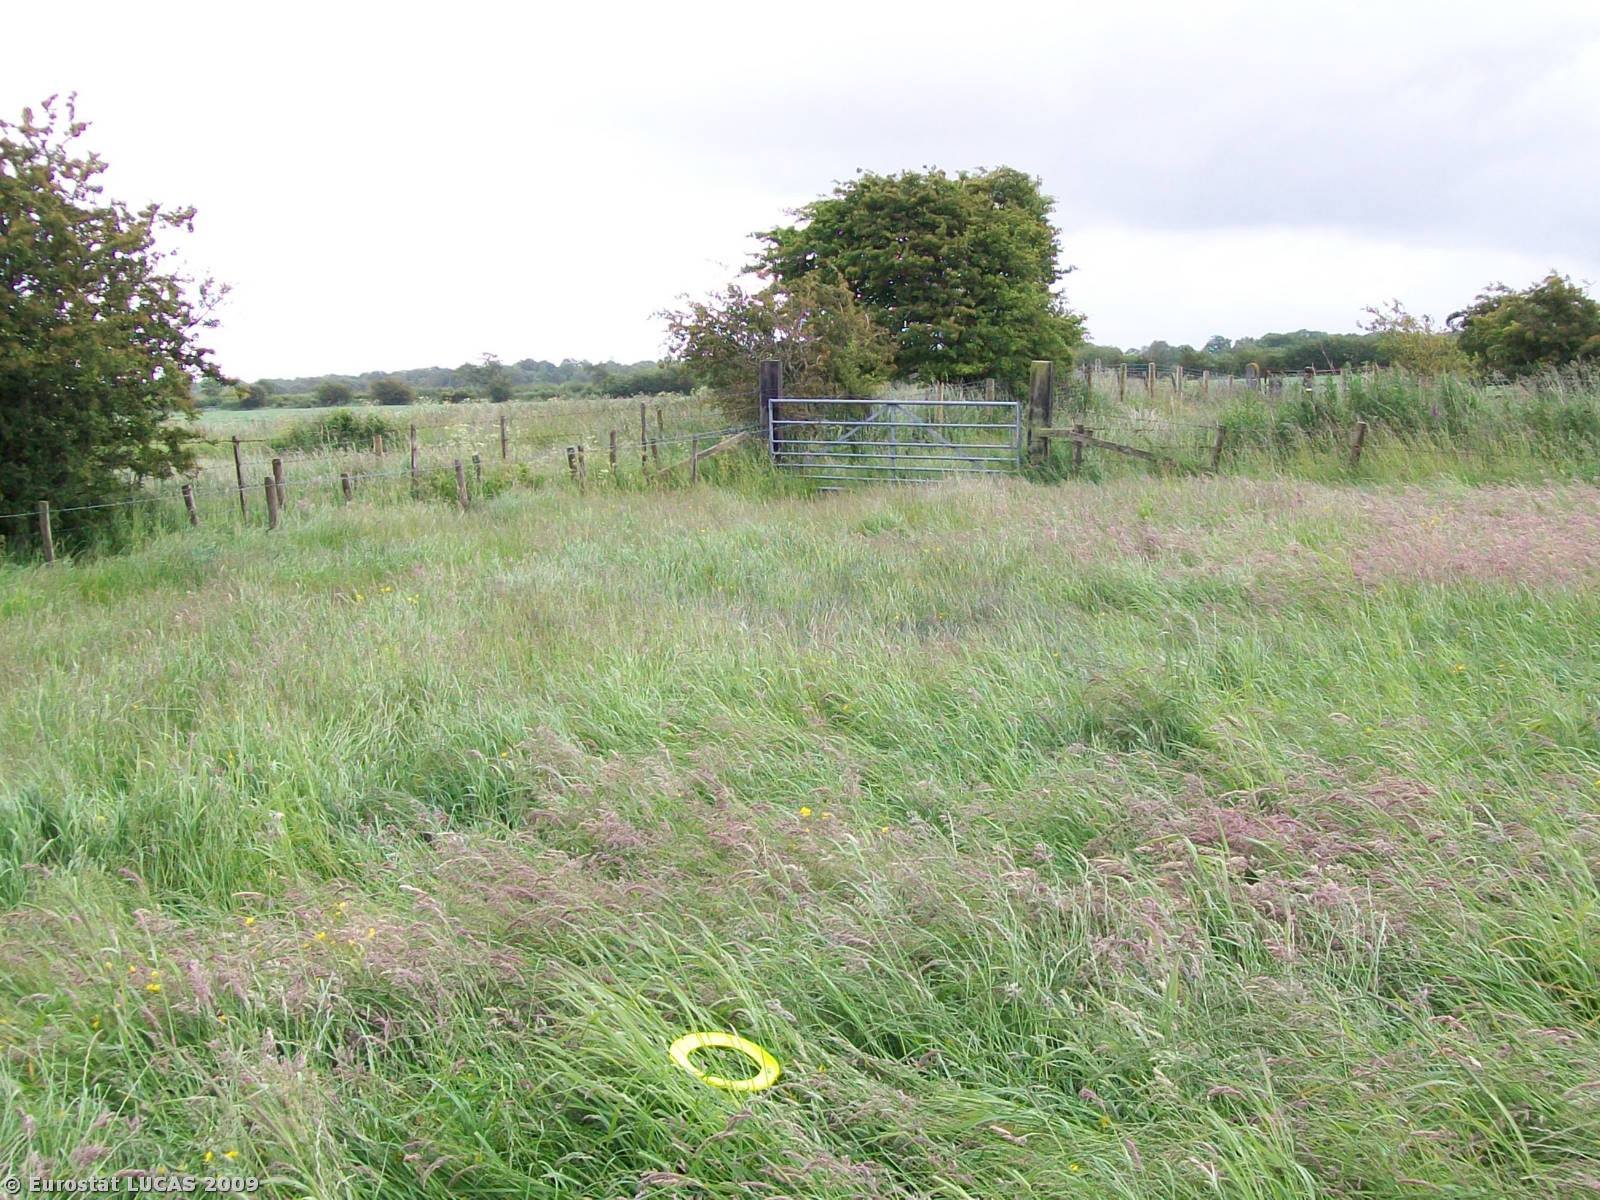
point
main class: Grassland
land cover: Grassland without tree/shrub cover
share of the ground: > 75 %
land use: Agriculture (excluding fallow land and kitchen gardens)
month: June
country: GB
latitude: 54.8767
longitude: -3.2456
